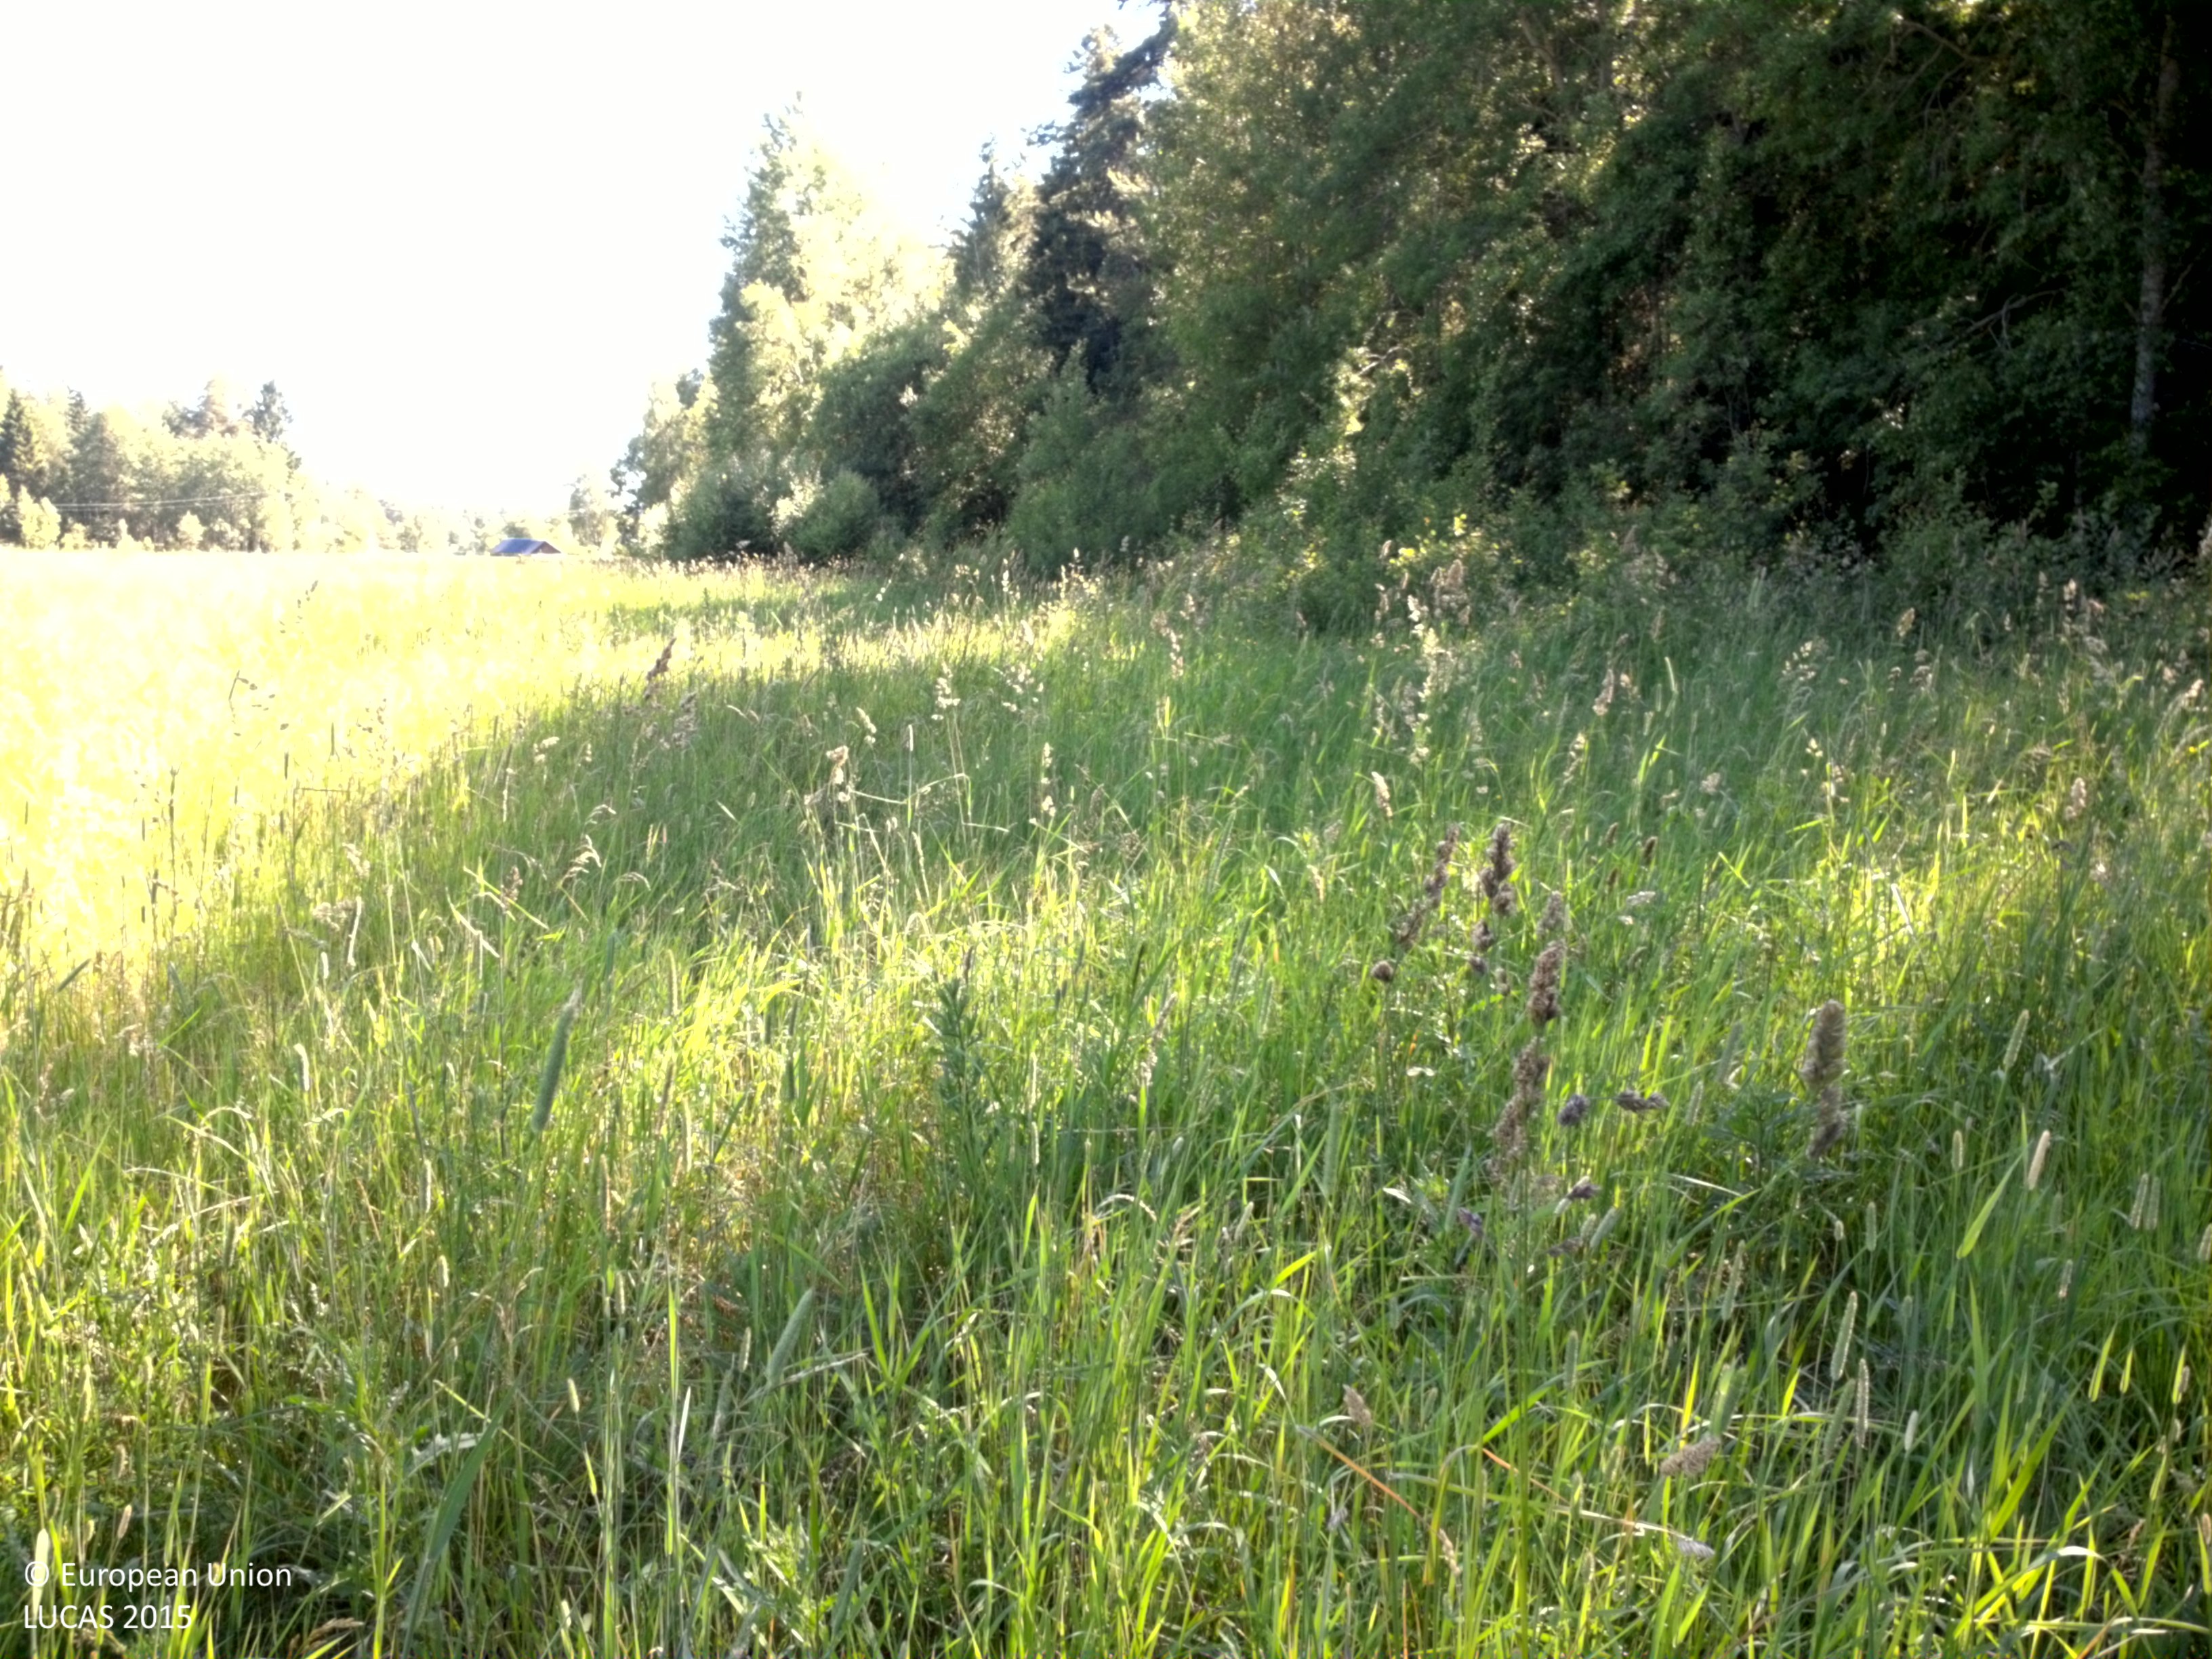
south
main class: Grassland
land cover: Grassland without tree/shrub cover
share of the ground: > 75 %
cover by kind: herbaceous plants 100 %
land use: Agriculture (excluding fallow land and kitchen gardens)
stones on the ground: < 10 %
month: July
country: SE
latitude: 59.7143
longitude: 18.3714
